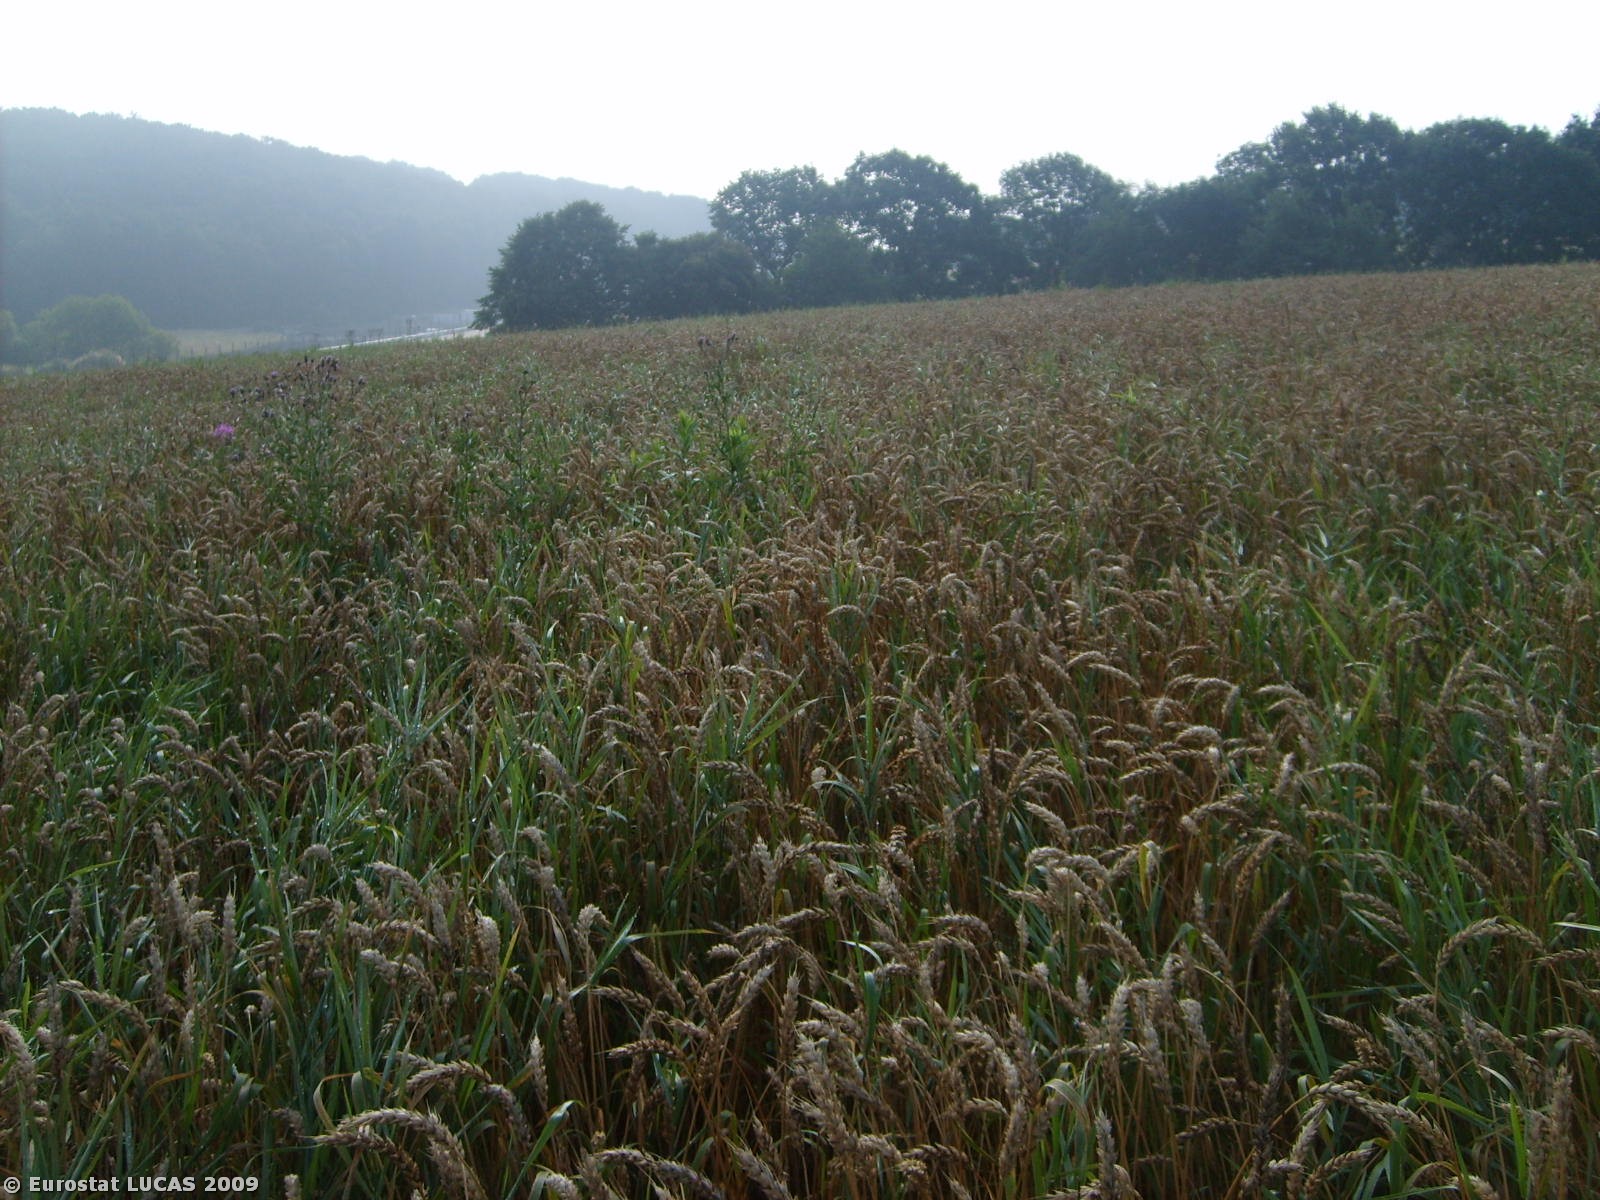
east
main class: Cropland
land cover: Common wheat
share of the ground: > 75 %
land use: Agriculture (excluding fallow land and kitchen gardens)
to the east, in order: Common wheat; Grass margins; Broadleaved woodland; Common wheat; Grass margins; Paved roads, cycling and walking lanes; Grass margins; Bare land
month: July
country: PL
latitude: 49.9971
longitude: 20.2040
